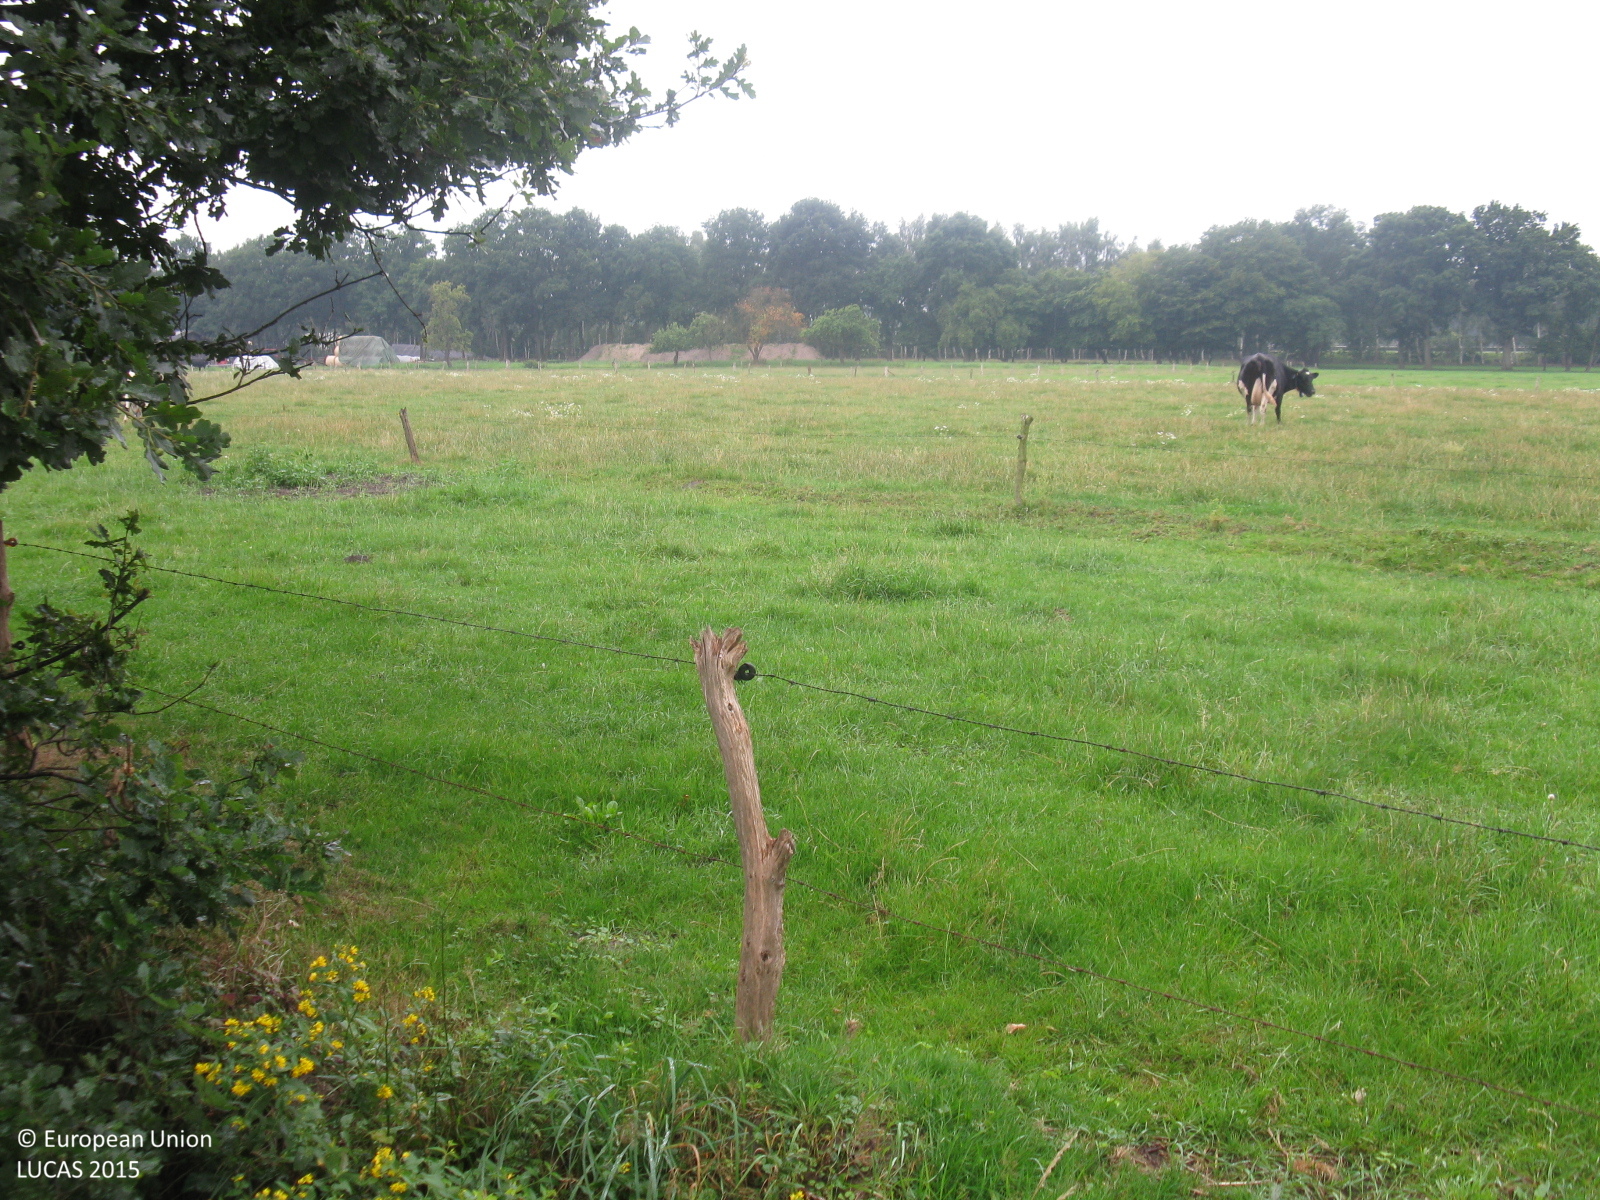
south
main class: Grassland
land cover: Grassland without tree/shrub cover
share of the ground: > 75 %
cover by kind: herbaceous plants 100 %
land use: Agriculture (excluding fallow land and kitchen gardens)
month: August
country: DE
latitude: 53.0670
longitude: 8.3440
